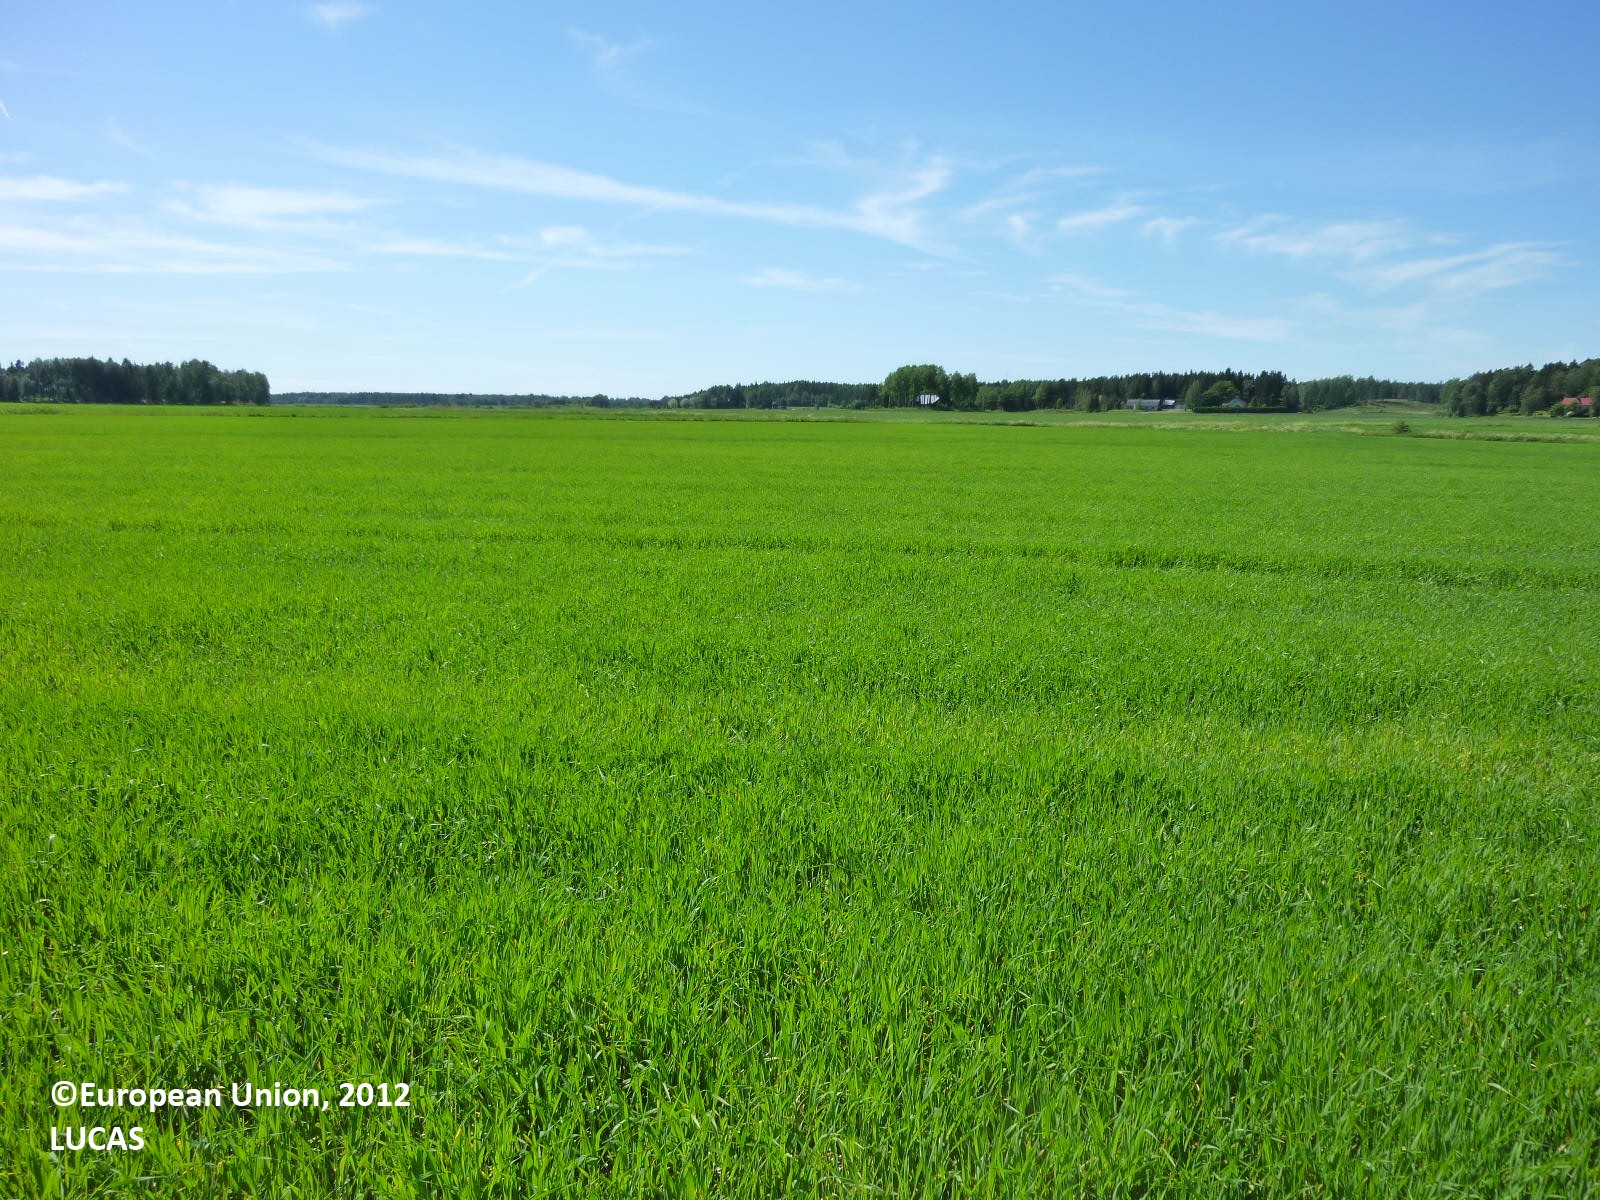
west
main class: Cropland
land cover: Barley
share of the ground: > 75 %
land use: Agriculture (excluding fallow land and kitchen gardens)
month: June
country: FI
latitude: 60.1081
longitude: 22.5761
